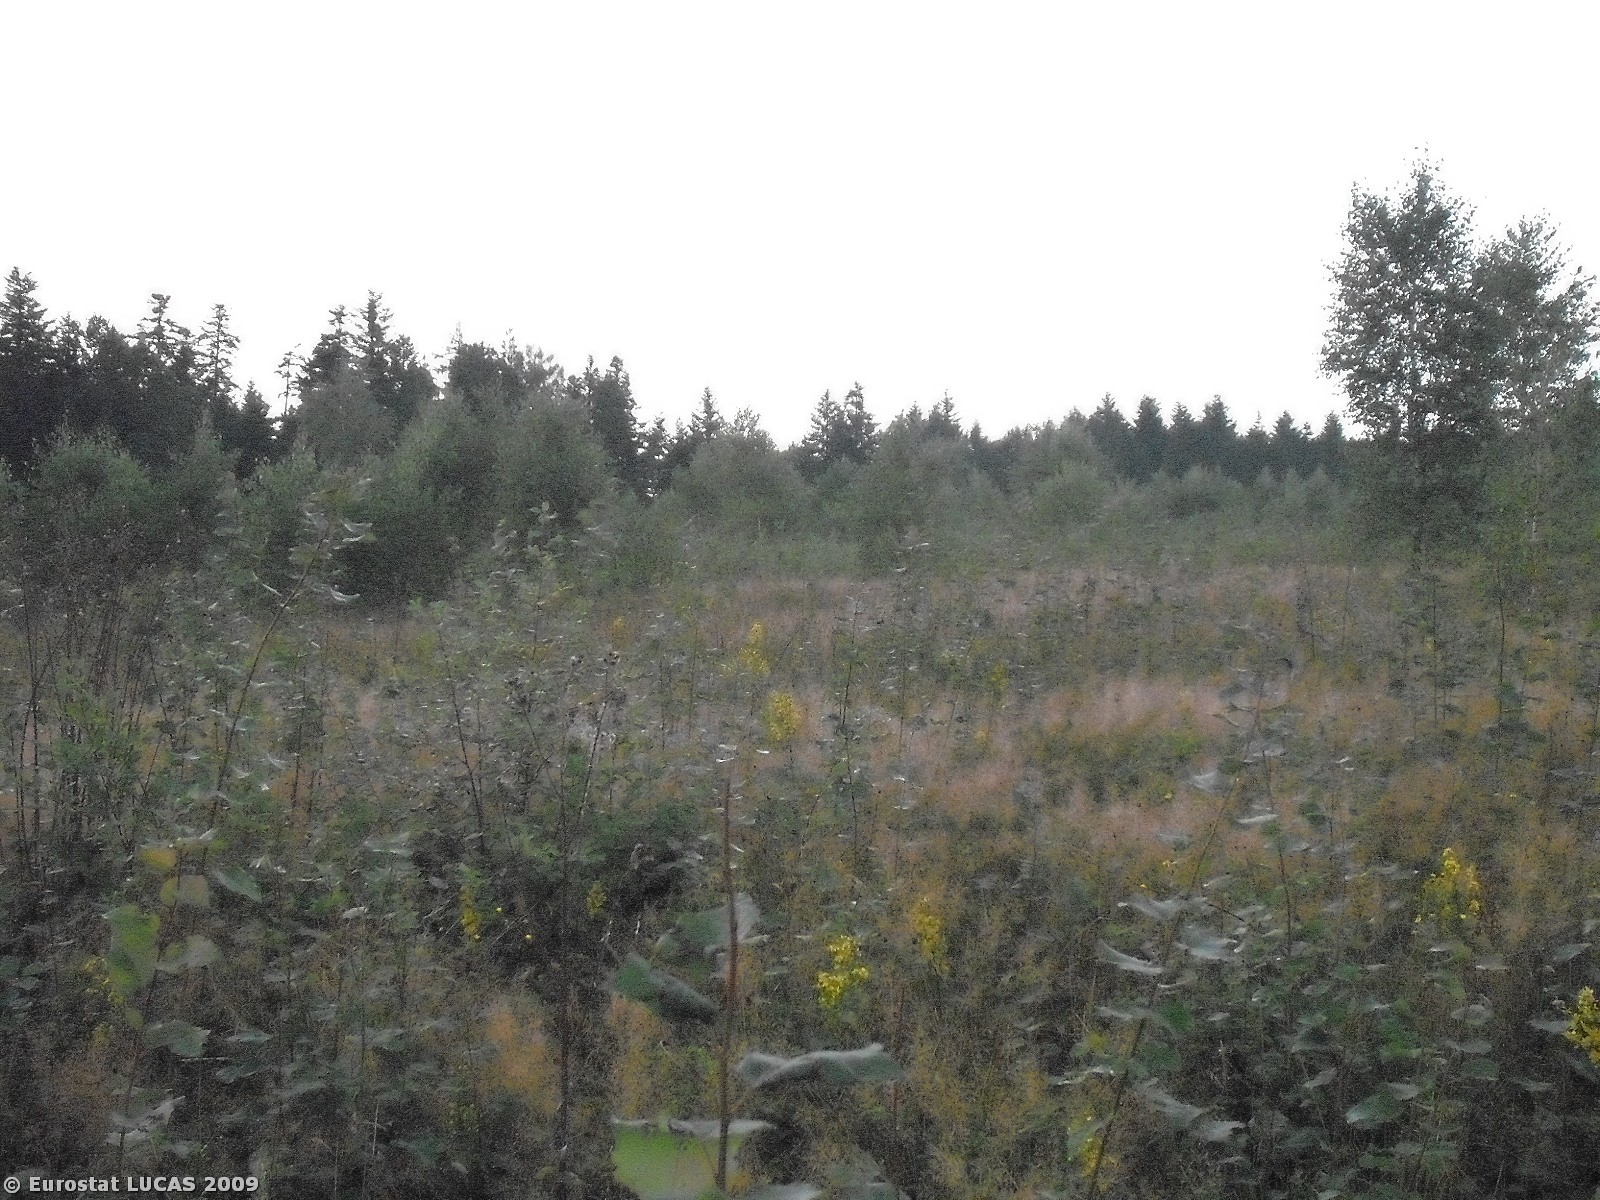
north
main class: Woodland
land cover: Broadleaved woodland
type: mesophytic deciduous forest
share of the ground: 25 - 50 %
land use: Unused
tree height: > 5 m
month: August
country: PL
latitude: 49.8002
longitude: 22.0196
